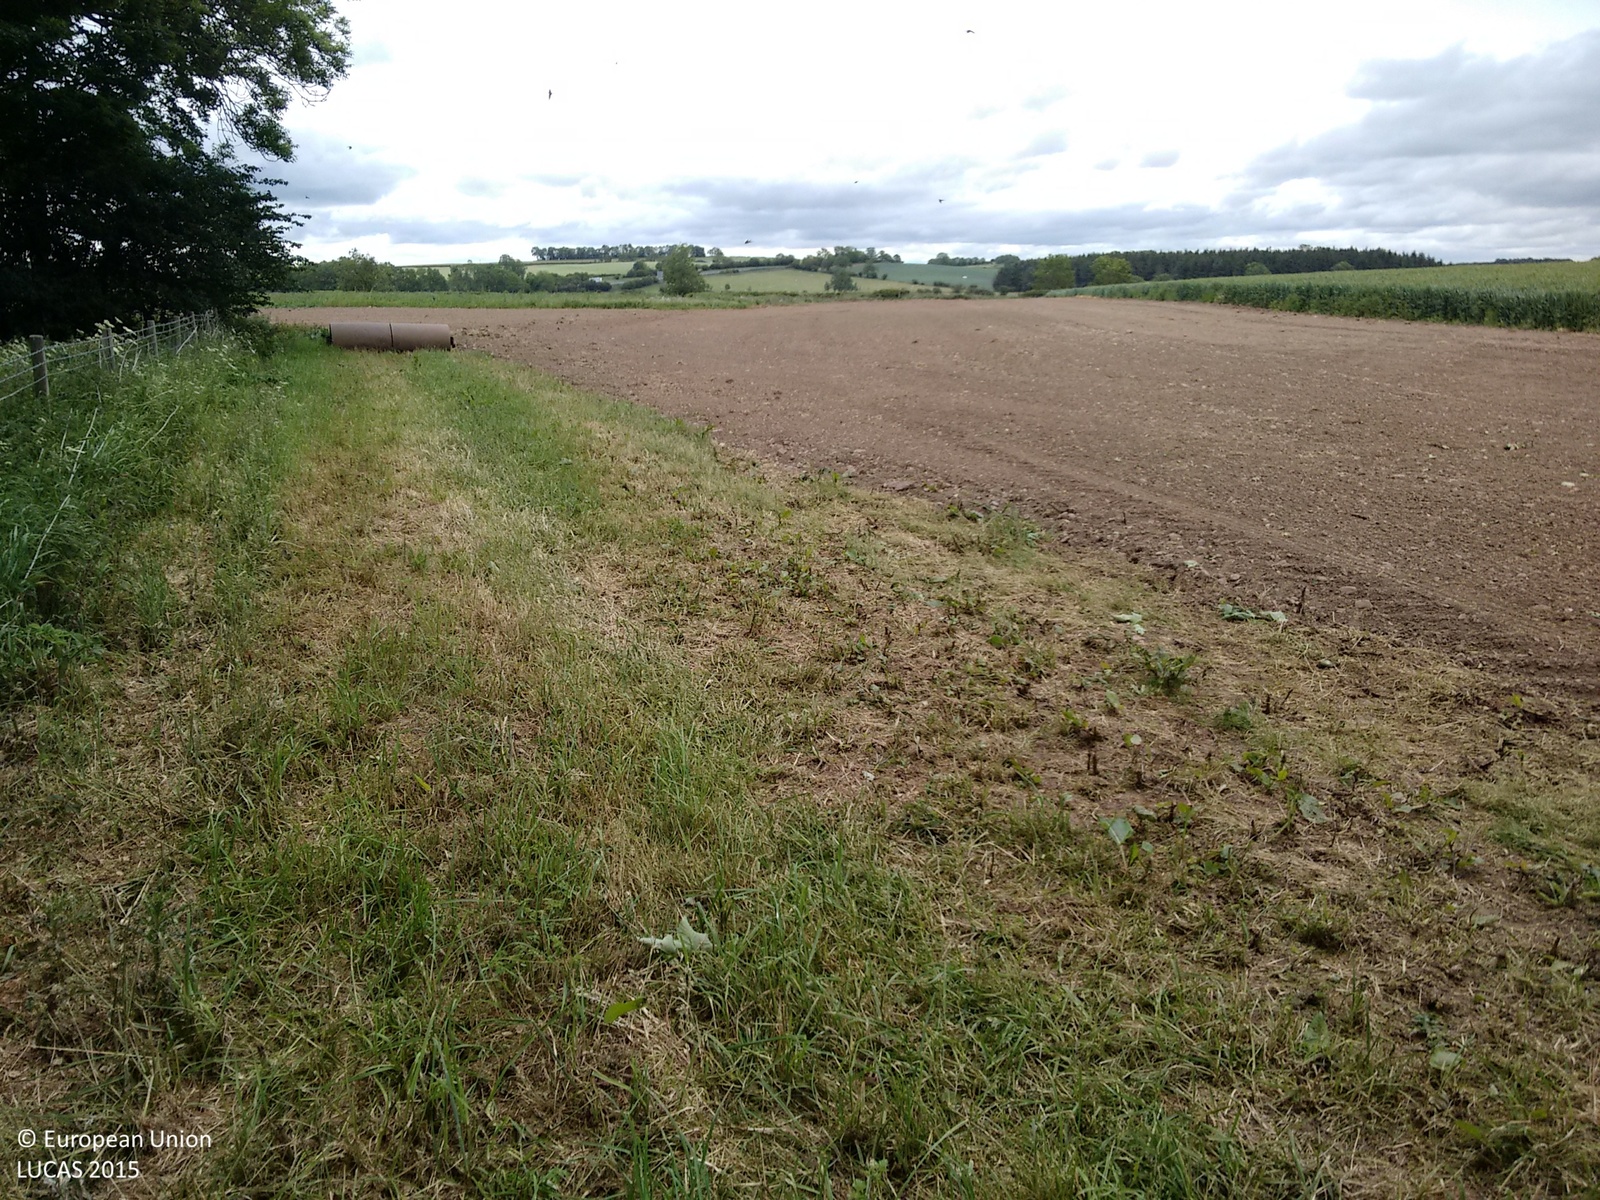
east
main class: Grassland
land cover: Spontaneously vegetated surfaces
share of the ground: > 75 %
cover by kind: herbaceous plants 100 %
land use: Agriculture (excluding fallow land and kitchen gardens)
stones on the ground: > 50 %
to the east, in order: Spontaneously vegetated surfaces; Other bare soil; Spontaneously vegetated surfaces; Other bare soil; Managed hedges; Paved roads, cycling and walking lanes; Managed hedges; Grassland without tree/shrub cover
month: June
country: GB
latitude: 54.4921
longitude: -1.8328
